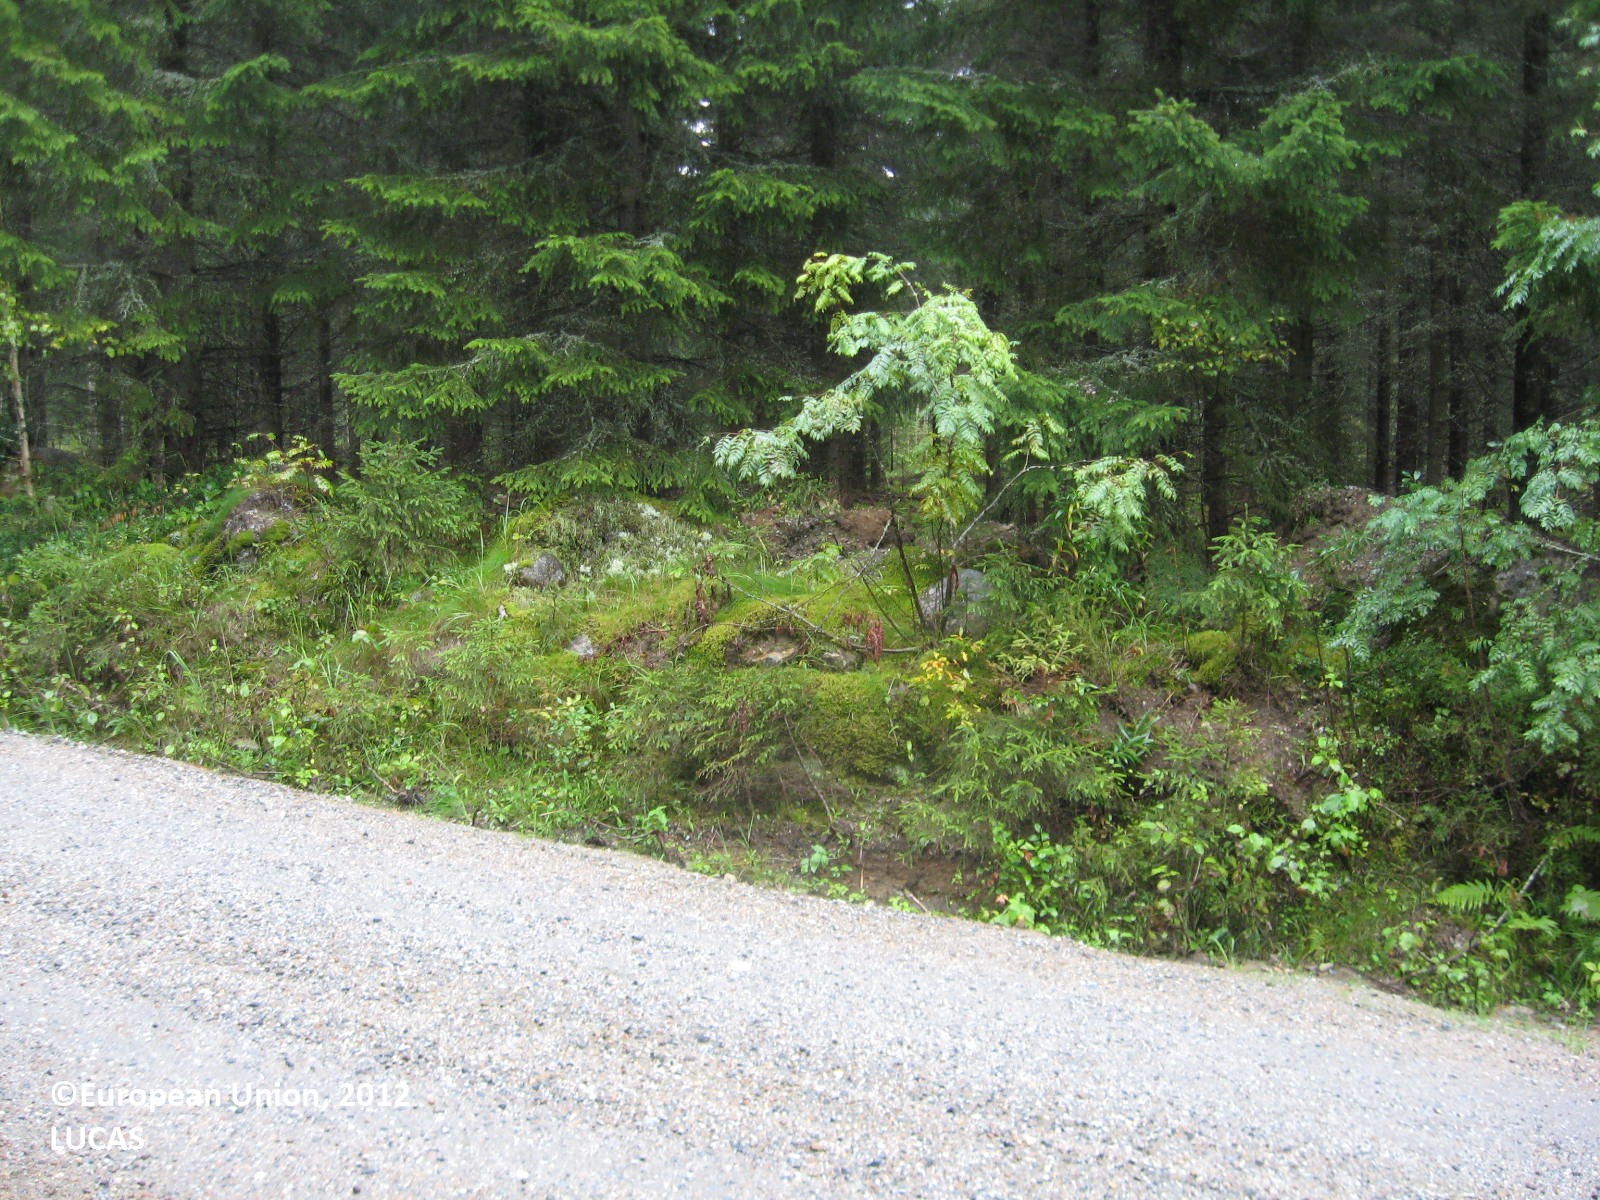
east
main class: Woodland
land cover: Spruce dominated coniferous woodland
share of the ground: > 75 %
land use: Forestry
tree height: > 5 m
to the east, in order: Spruce dominated coniferous woodland; Ditches and canals; Paved roads, cycling and walking lanes; Ditches and canals; Shruby margins; Spruce dominated coniferous woodland; Broadleaved woodland; Ditches and canals; Spruce dominated mixed woodland; Ditches and canals; Spruce dominated mixed woodland; Other mixed woodland
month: August
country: FI
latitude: 63.5694
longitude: 29.5809
